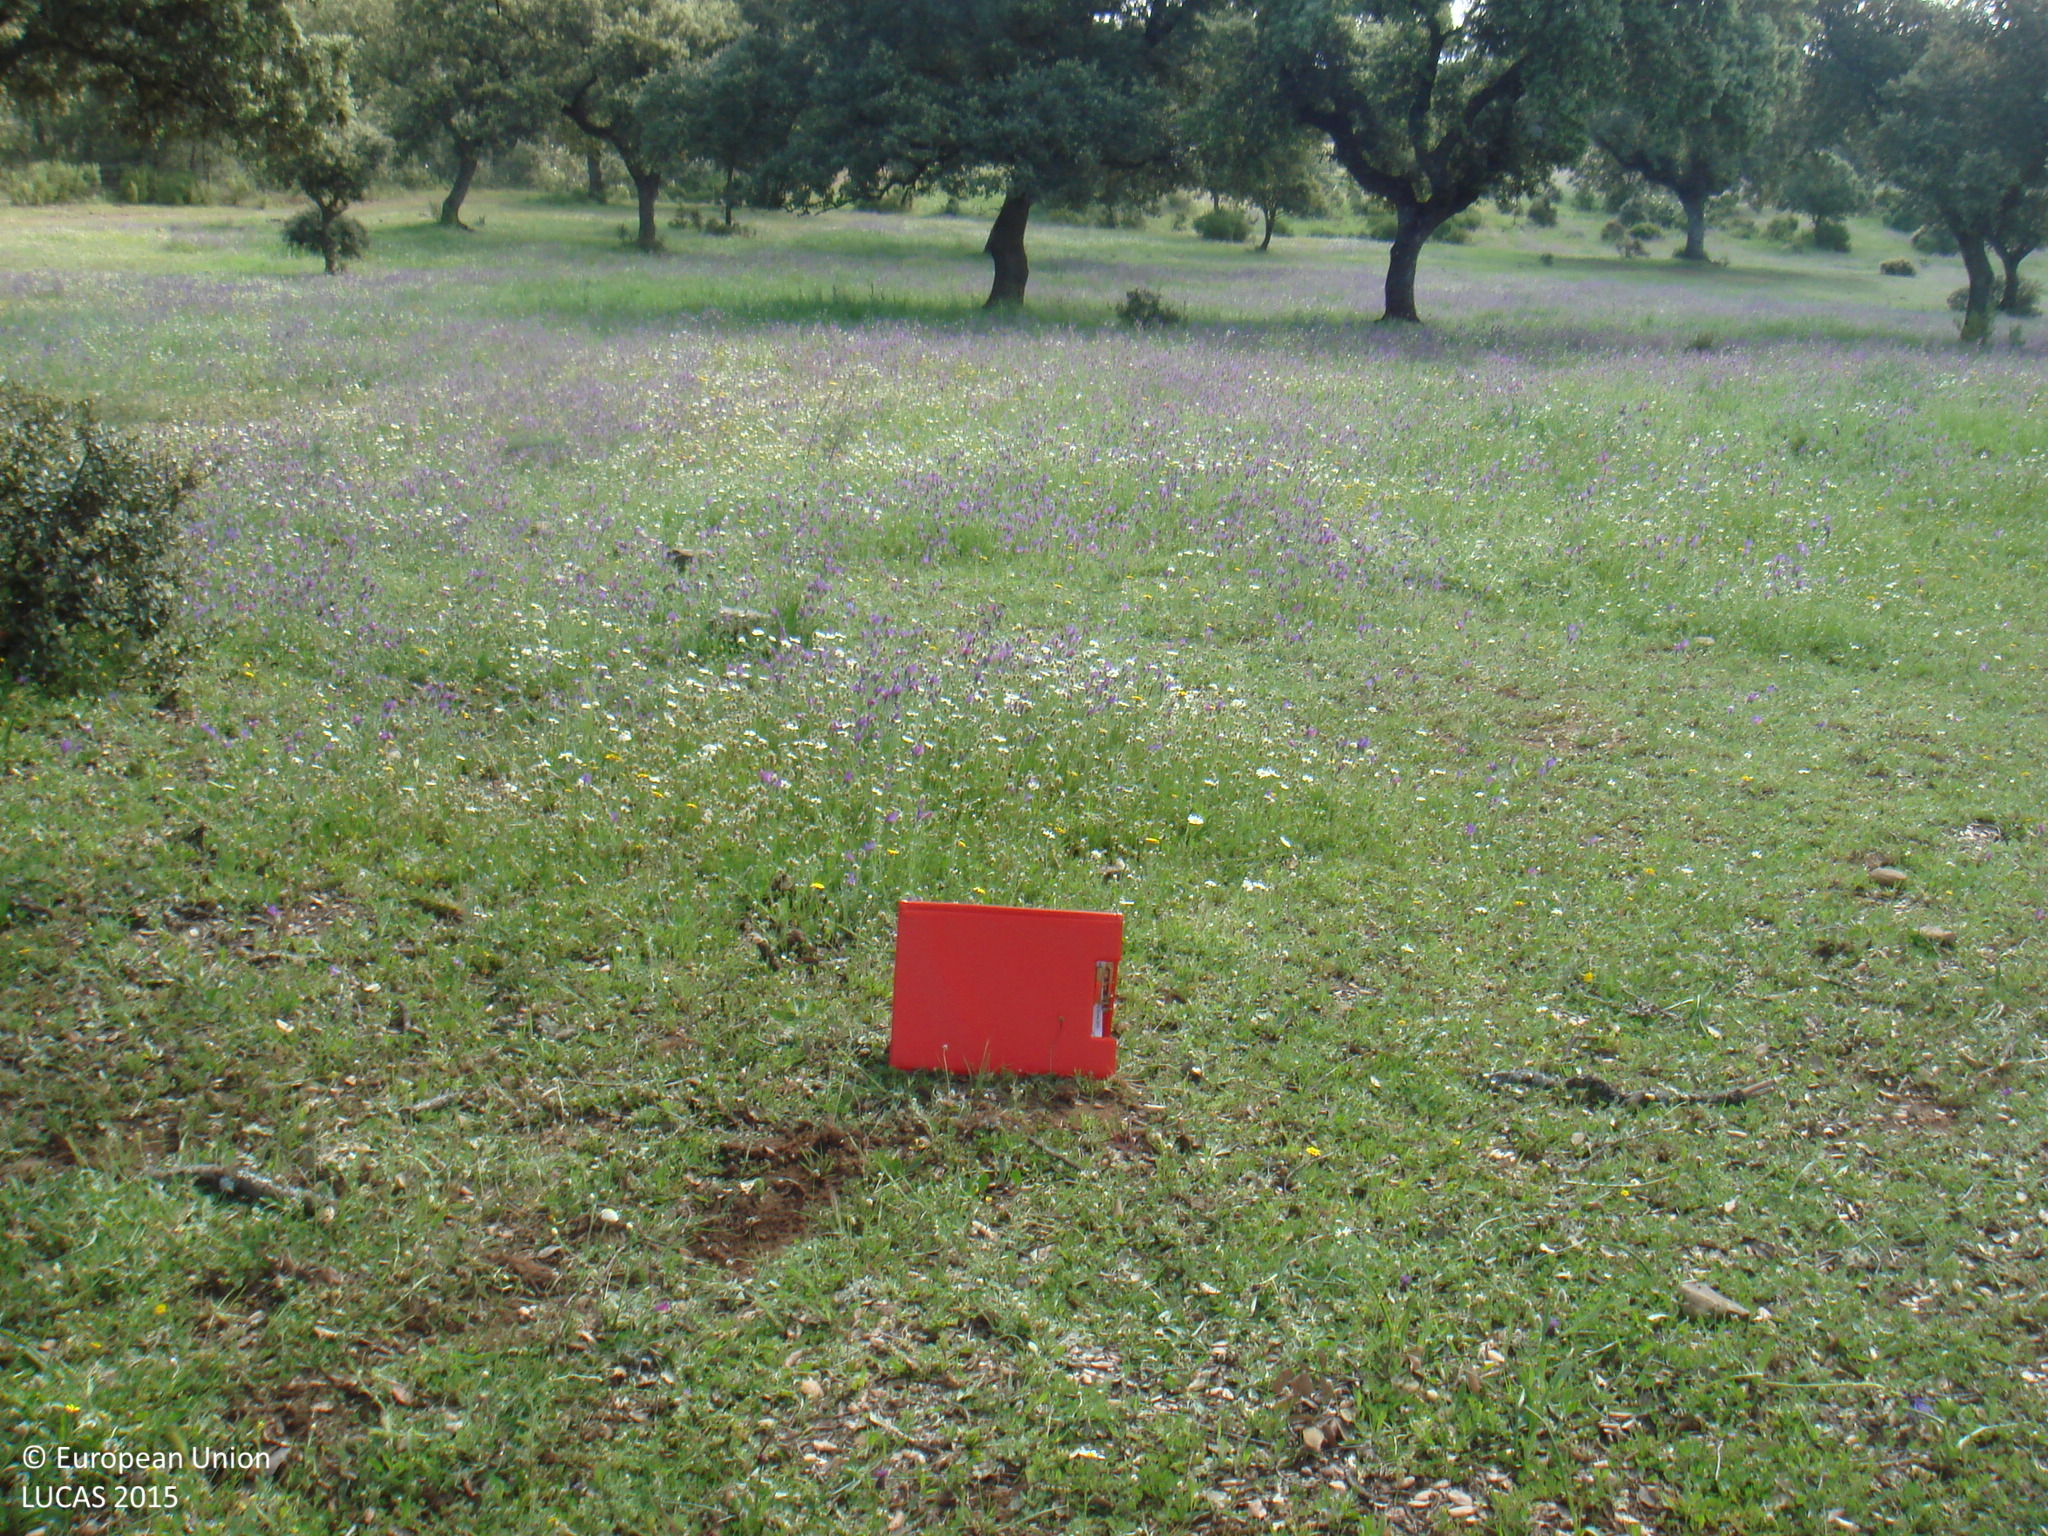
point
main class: Woodland
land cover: Broadleaved woodland
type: broadleaved evergreen forest
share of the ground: 25 - 50 %
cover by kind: herbaceous plants 60 %, broadleaved forest trees 30 %, shrubs 10 %
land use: Forestry
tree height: > 5 m
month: April
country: ES
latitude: 38.1929
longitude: -5.0842
